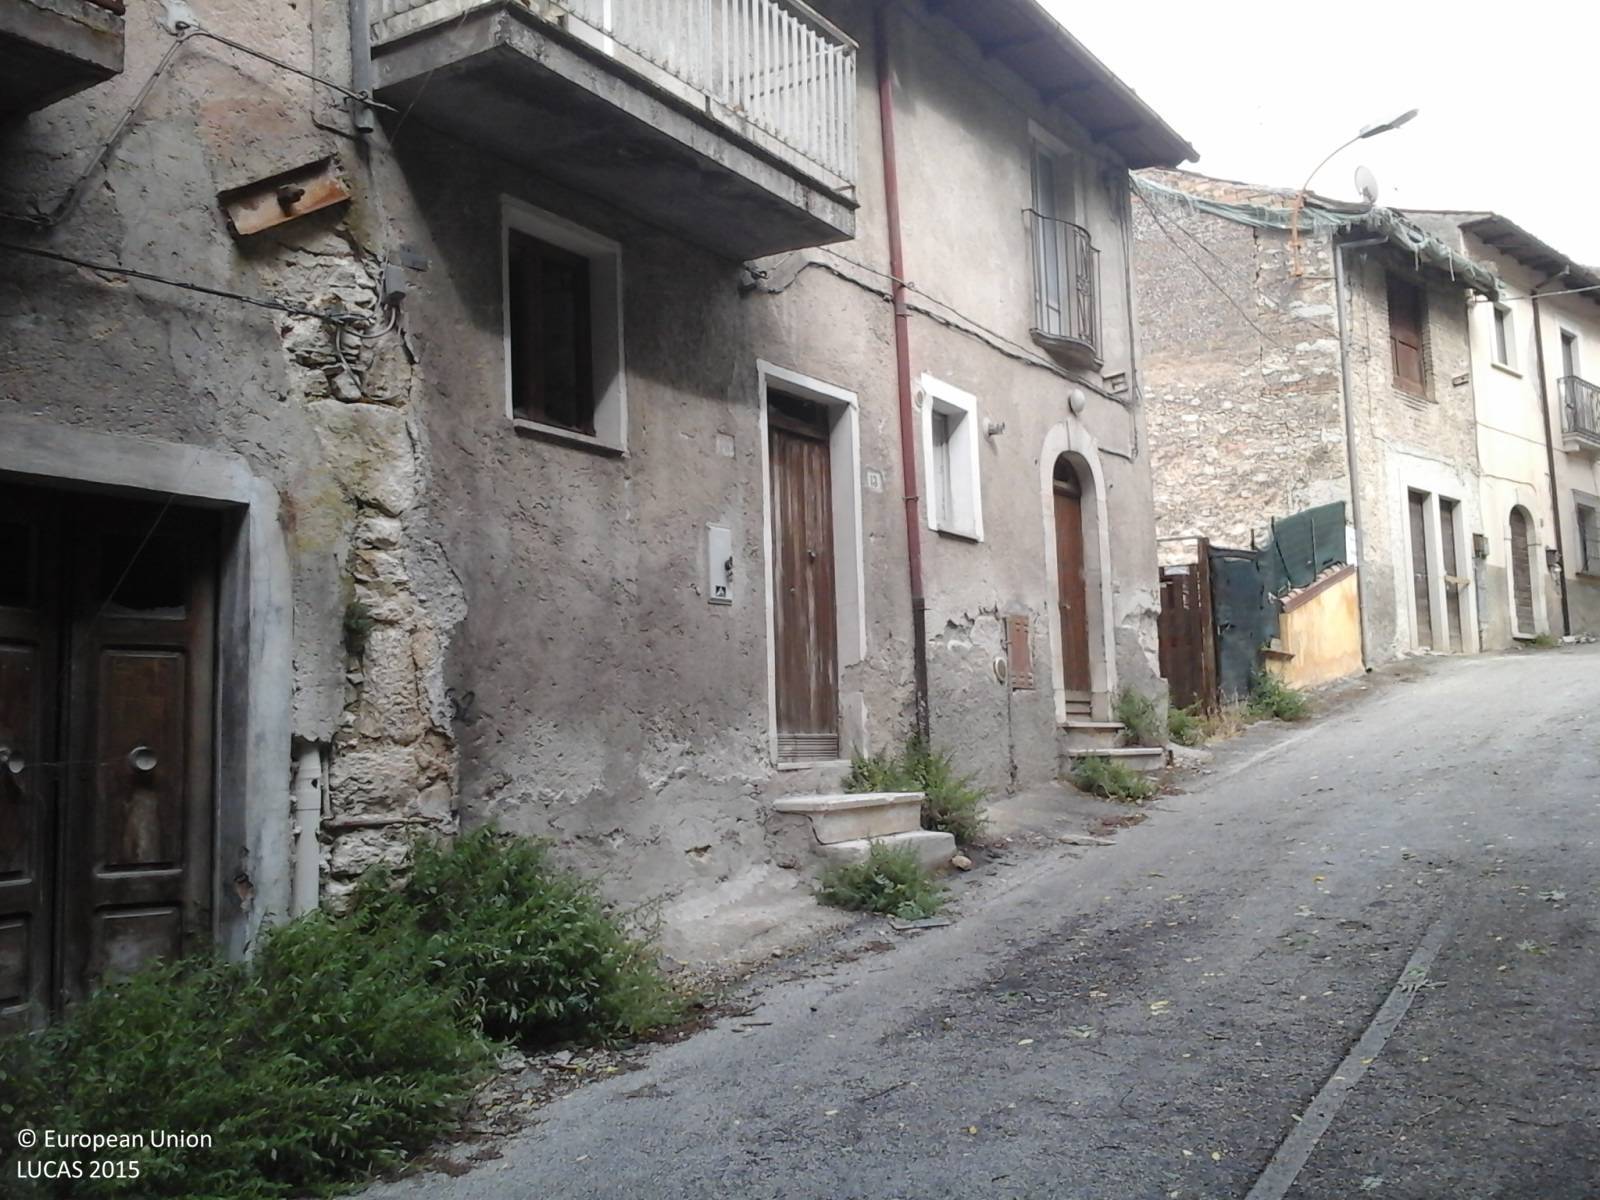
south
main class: Woodland
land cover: Broadleaved woodland
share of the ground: > 75 %
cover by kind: broadleaved forest trees 95 %, coniferous forest trees 5 %
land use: Amenities, museums, leisure
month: July
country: IT
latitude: 42.3595
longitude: 13.4734
